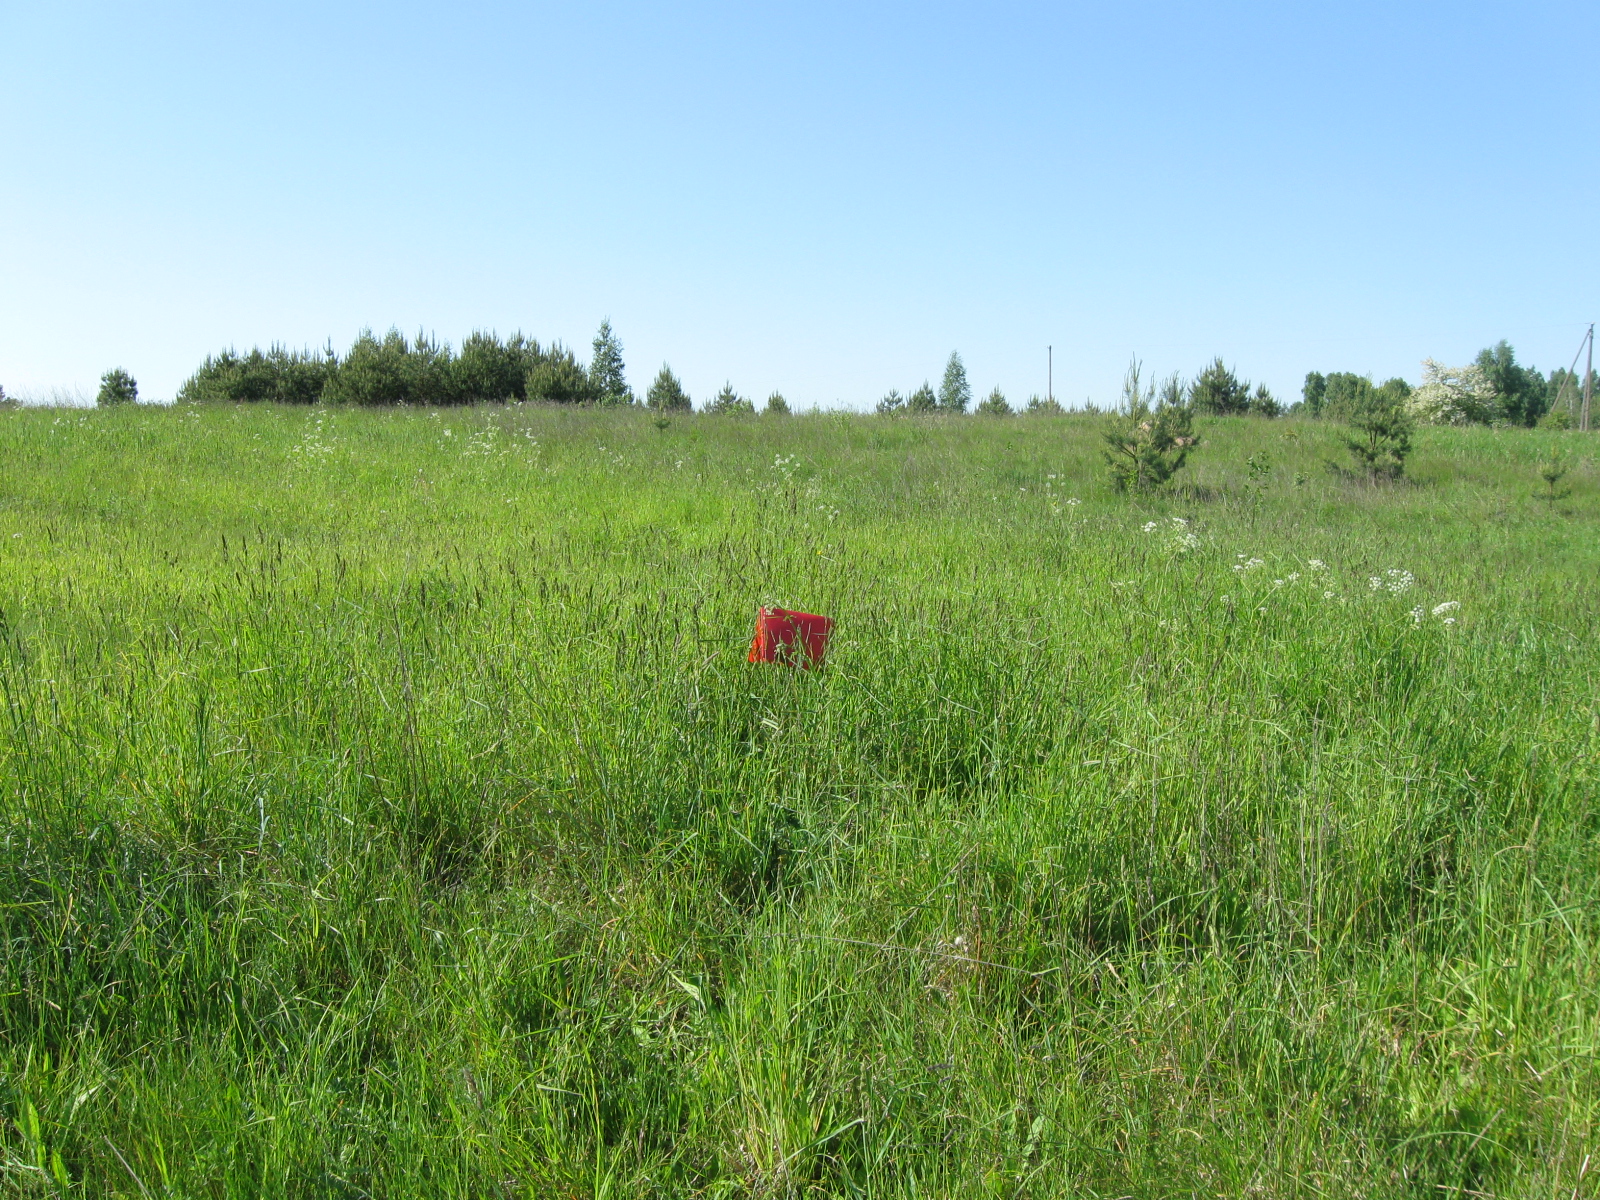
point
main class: Grassland
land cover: Grassland without tree/shrub cover
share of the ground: > 75 %
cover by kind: herbaceous plants 100 %
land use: Agriculture (excluding fallow land and kitchen gardens)
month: June
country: LT
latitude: 54.1753
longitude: 23.4874
